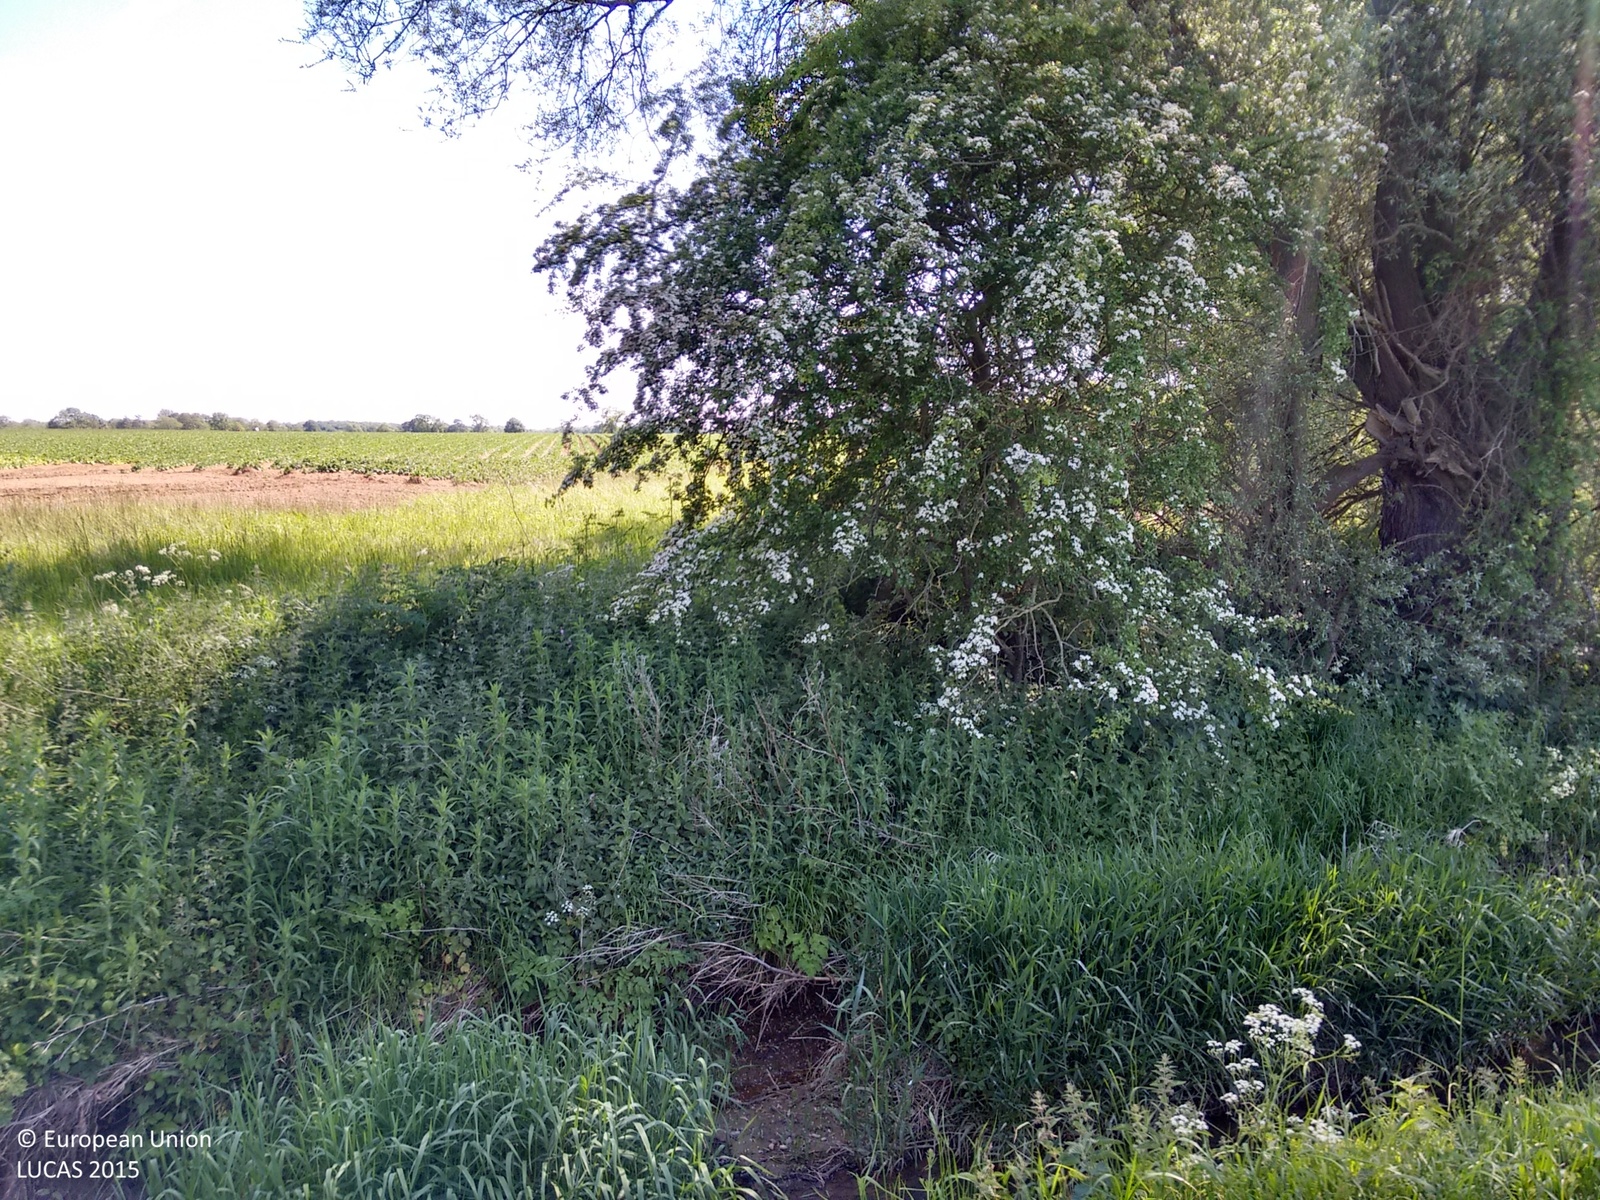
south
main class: Grassland
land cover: Spontaneously vegetated surfaces
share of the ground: > 75 %
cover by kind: herbaceous plants 100 %
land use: Agriculture (excluding fallow land and kitchen gardens)
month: June
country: GB
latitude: 54.0693
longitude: -0.9062
